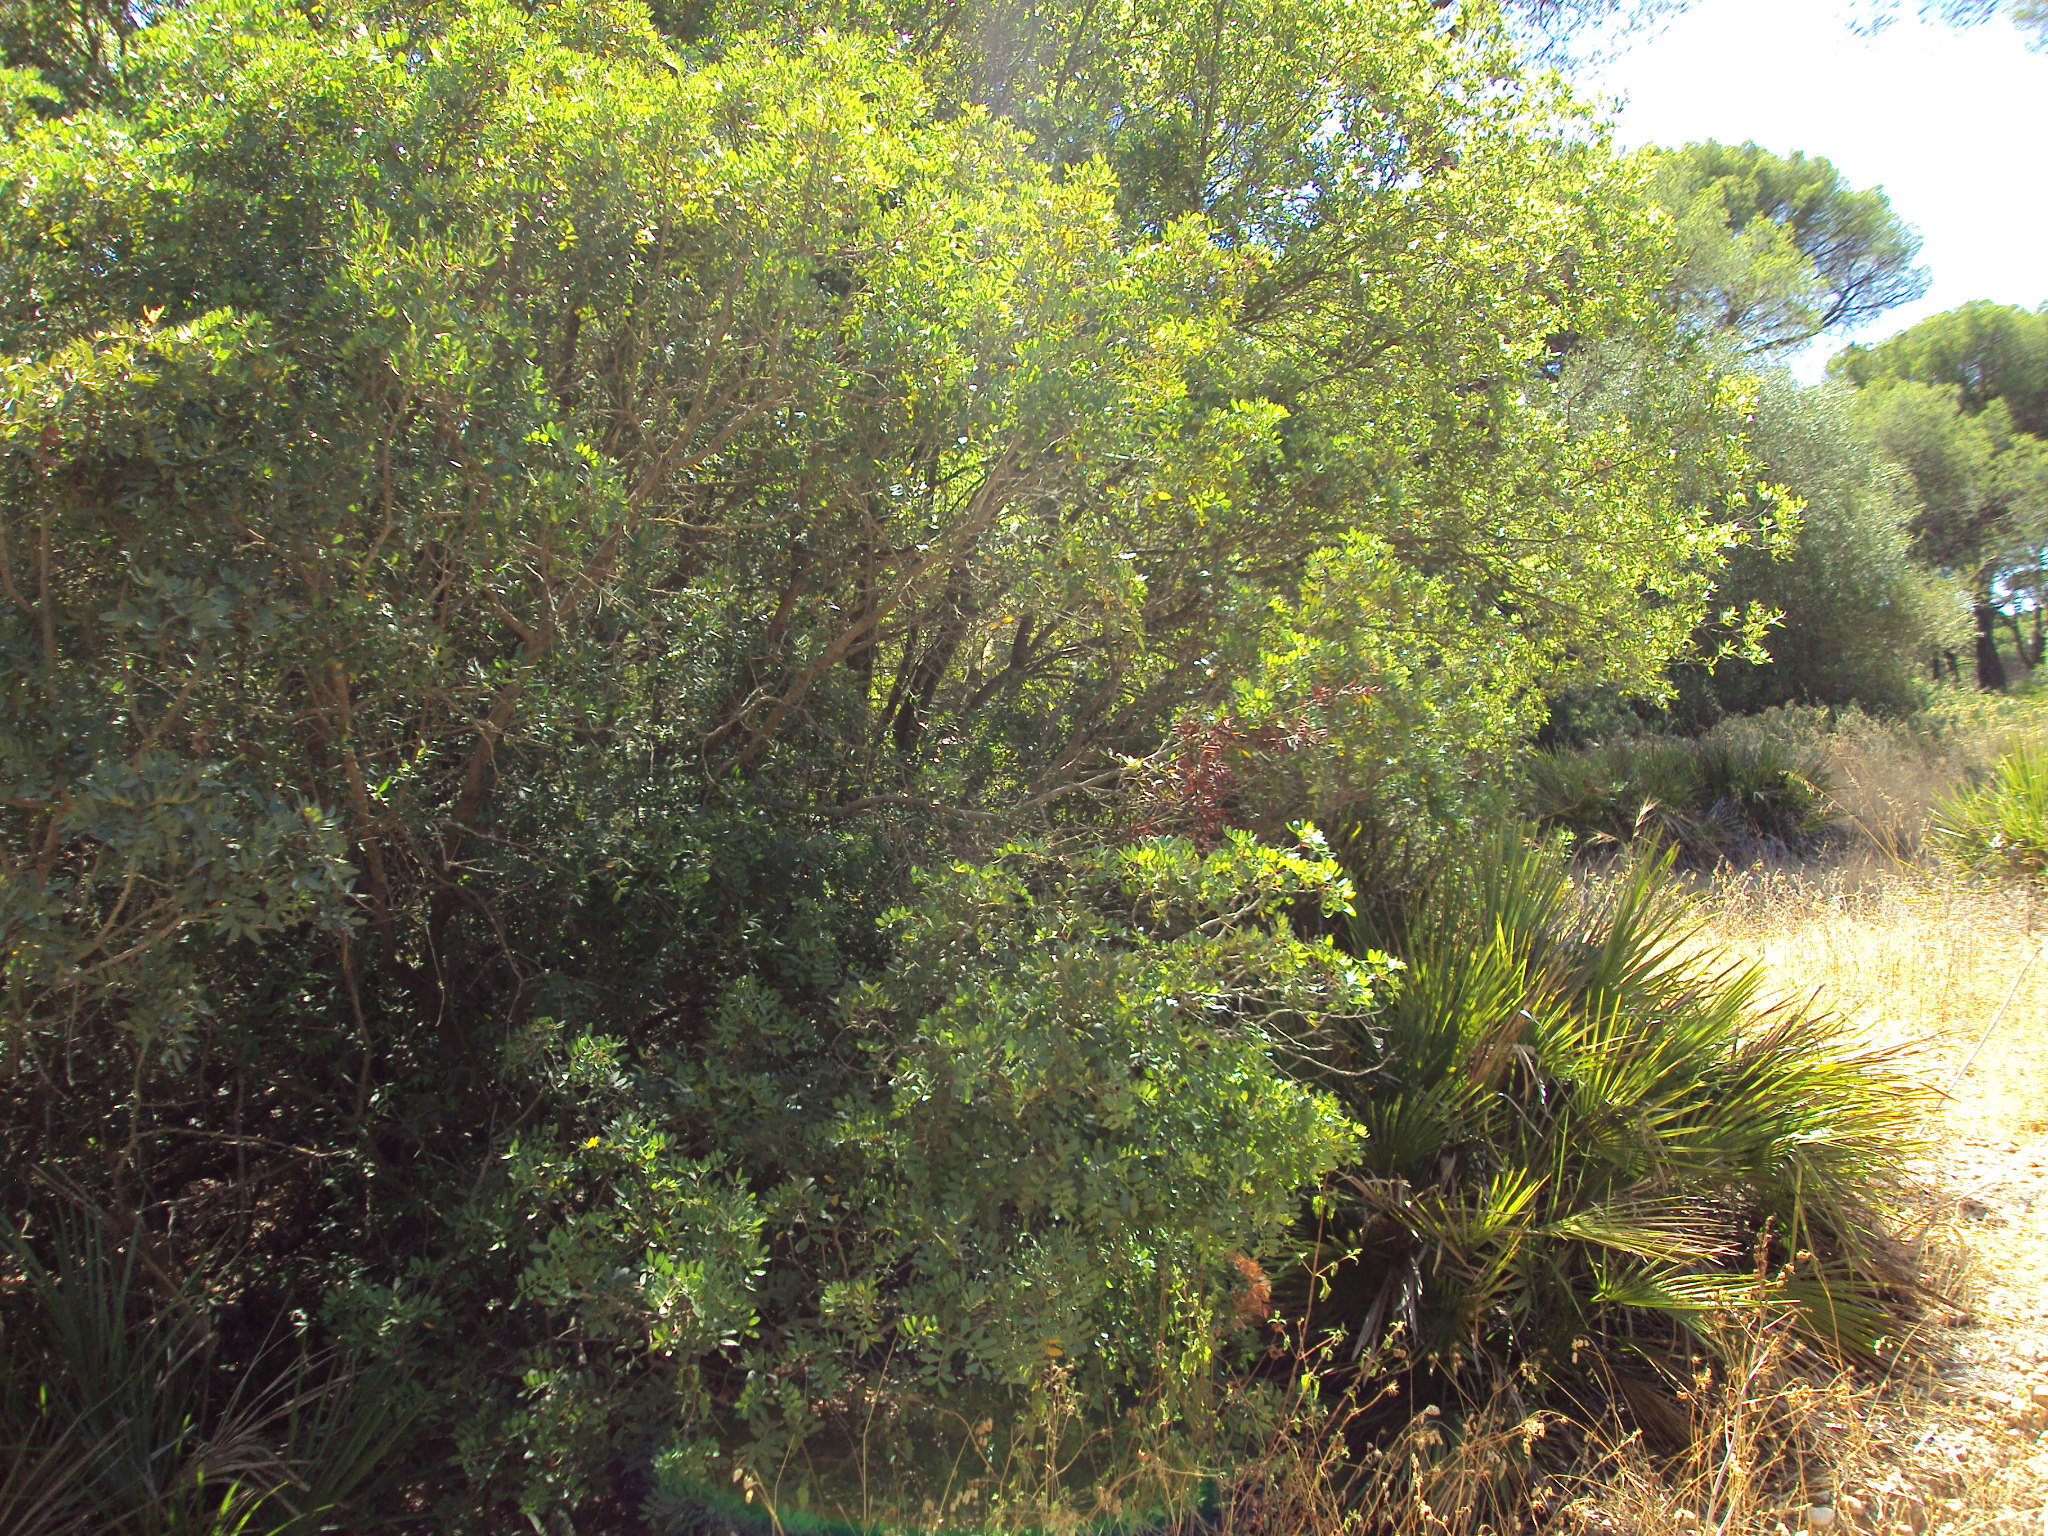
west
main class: Woodland
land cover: Pine dominated coniferous woodland
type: coniferous forest of the mediterranean region
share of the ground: 50 - 75 %
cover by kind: coniferous forest trees 70 %, herbaceous plants 20 %, shrubs 10 %
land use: Forestry
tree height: > 5 m
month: July
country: ES
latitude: 37.2136
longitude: -6.8367
